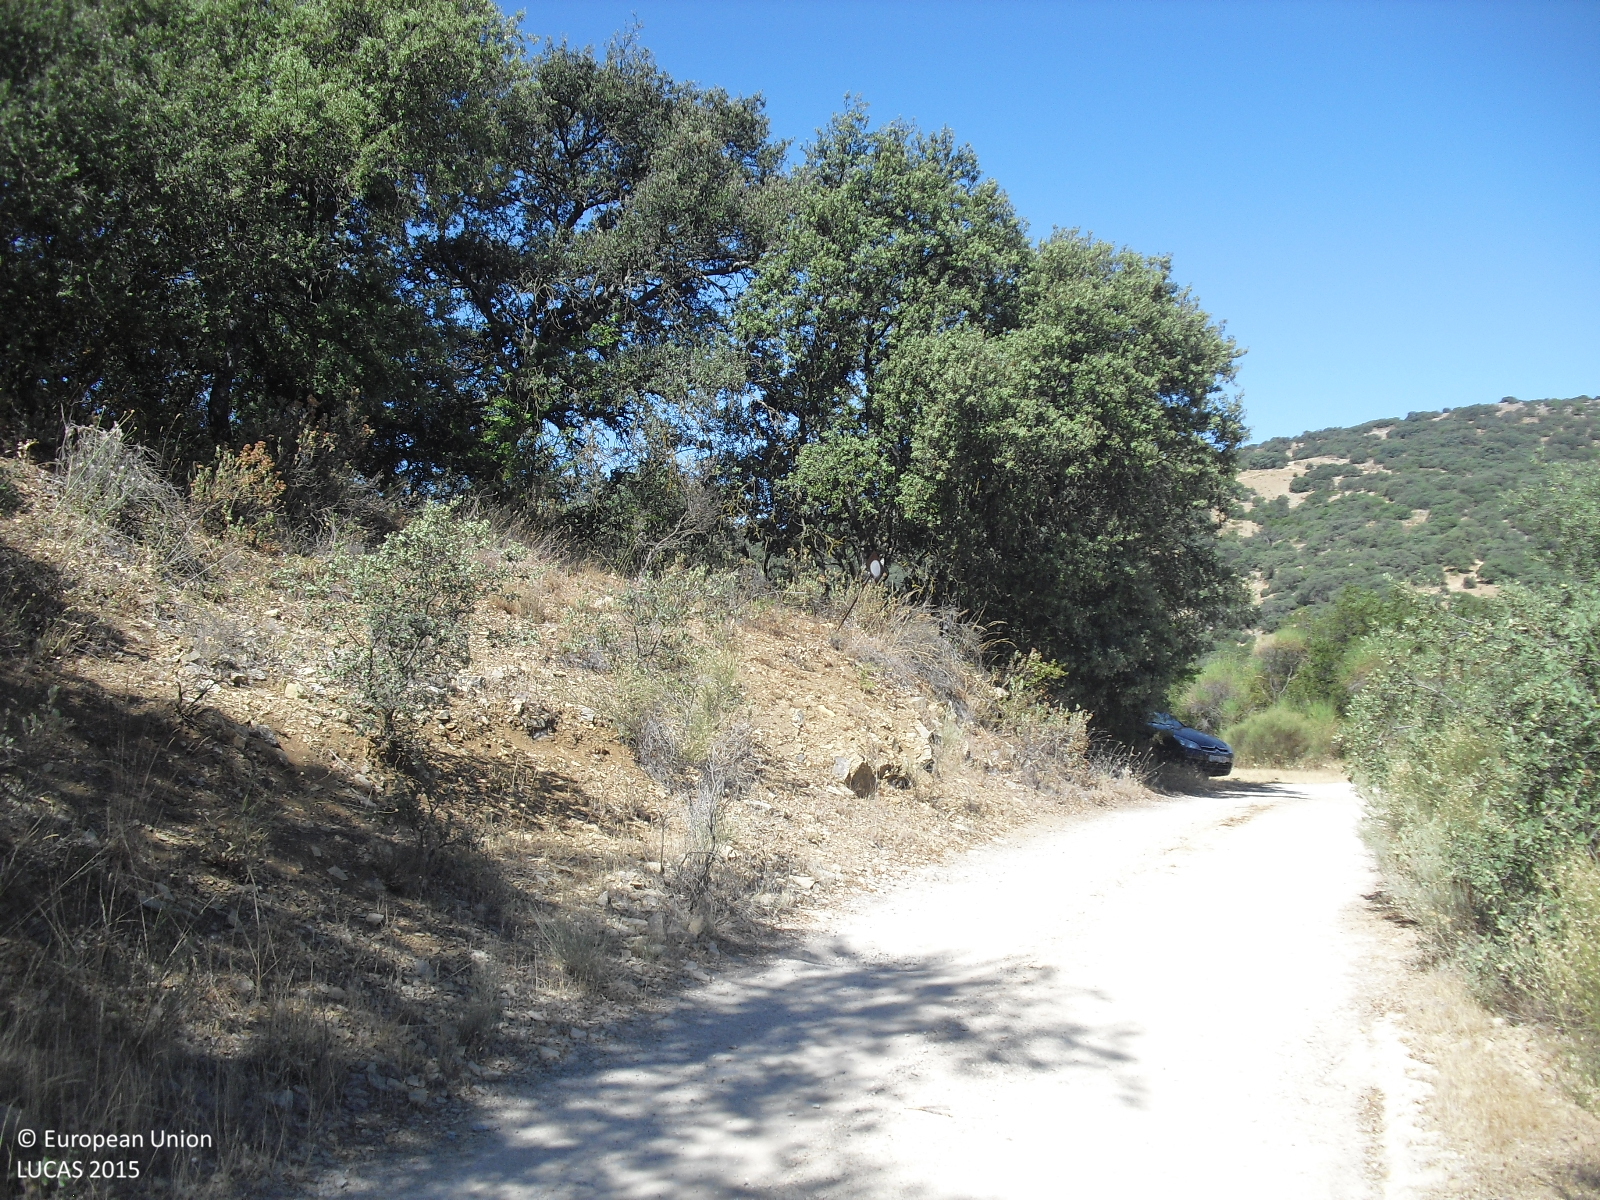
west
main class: Cropland
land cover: Olive groves
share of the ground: 25 - 50 %
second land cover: Other bare soil
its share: > 75 %
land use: Agriculture (excluding fallow land and kitchen gardens)
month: August
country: ES
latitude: 37.2964
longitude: -4.1088
